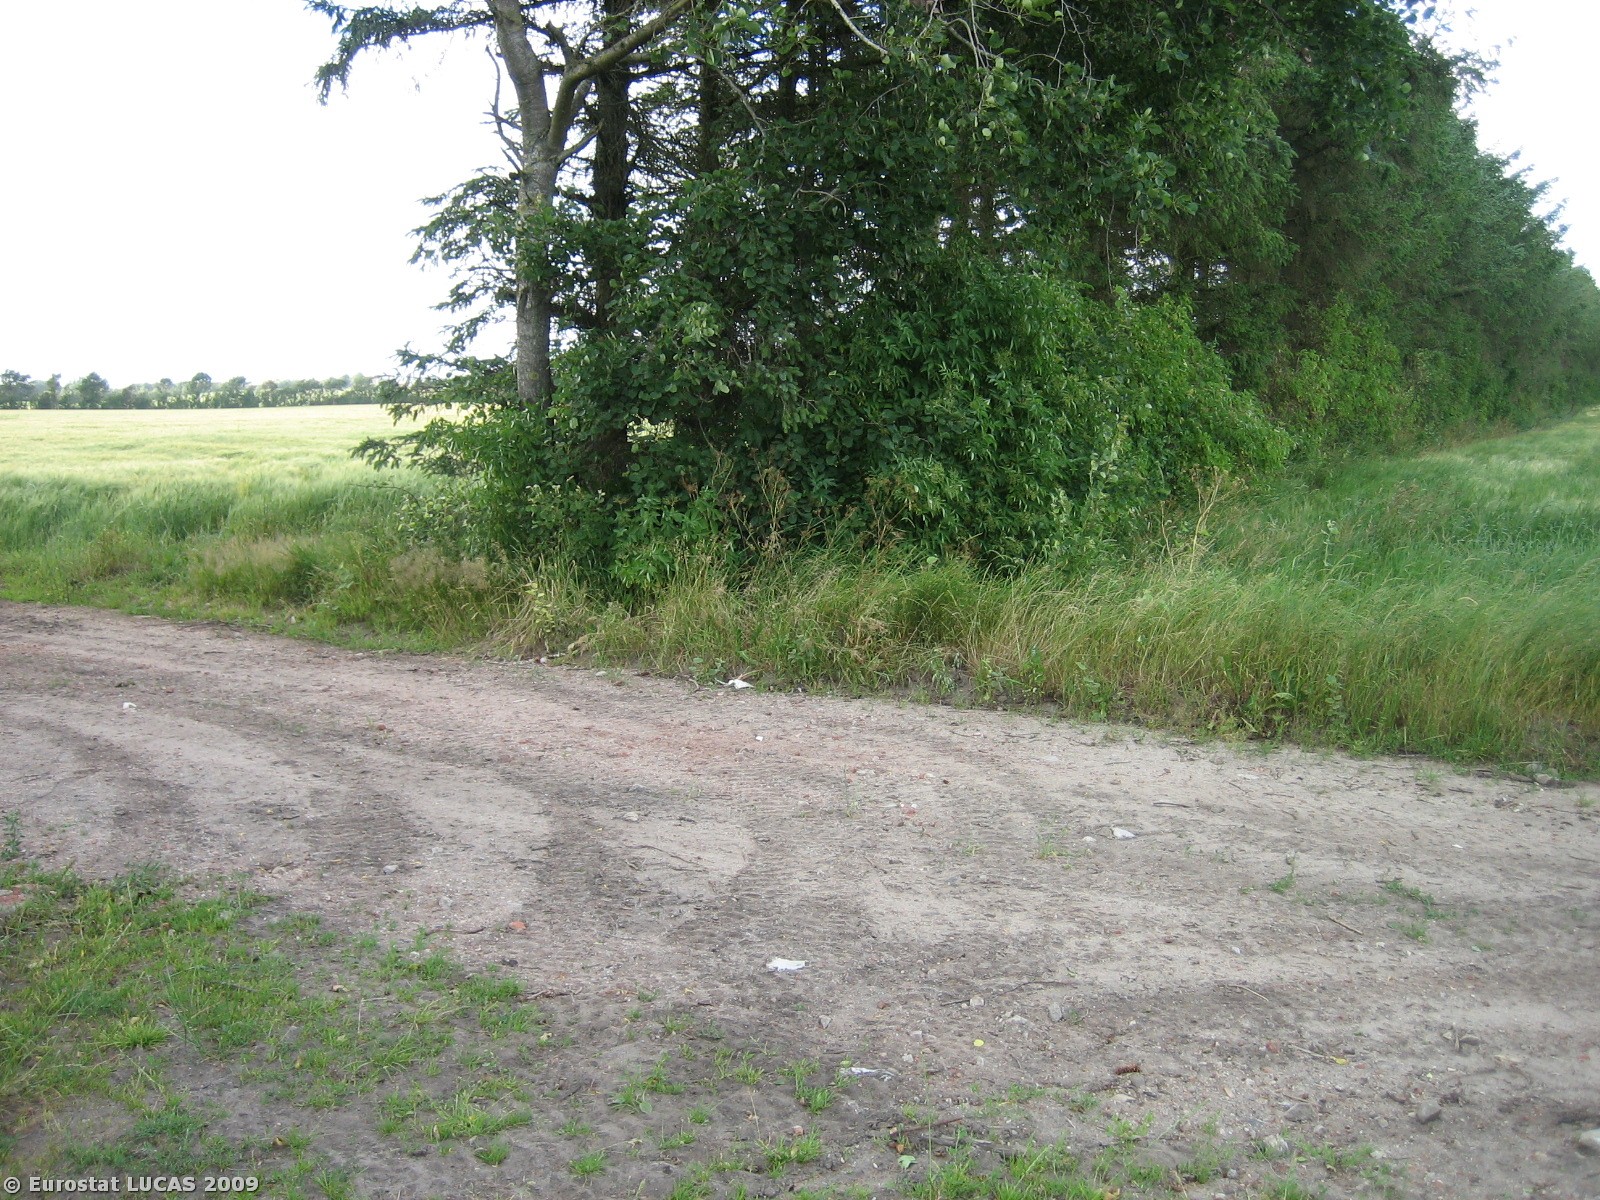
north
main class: Cropland
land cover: Barley
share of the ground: 25 - 50 %
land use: Agriculture (excluding fallow land and kitchen gardens)
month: July
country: DK
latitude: 55.7107
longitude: 8.4258
